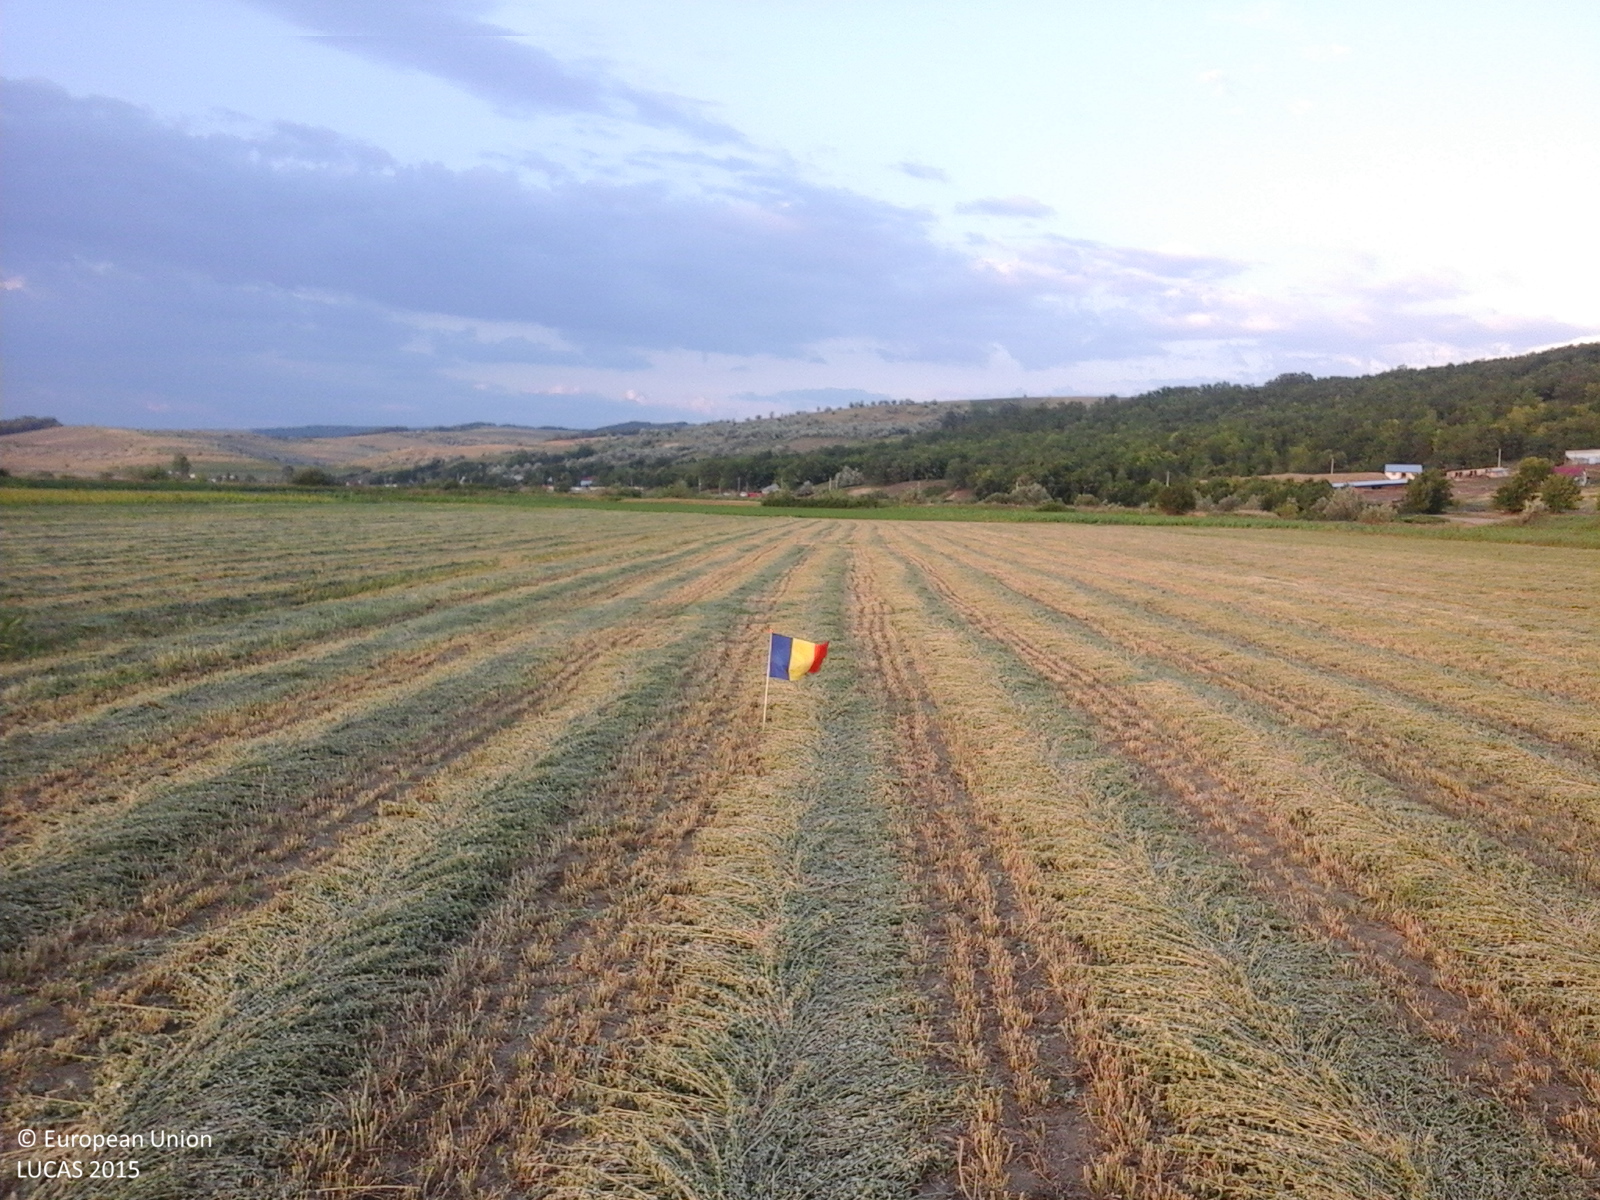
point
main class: Cropland
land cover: Lucerne
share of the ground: 25 - 50 %
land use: Agriculture (excluding fallow land and kitchen gardens)
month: June
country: RO
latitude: 46.8530
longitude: 27.7888
